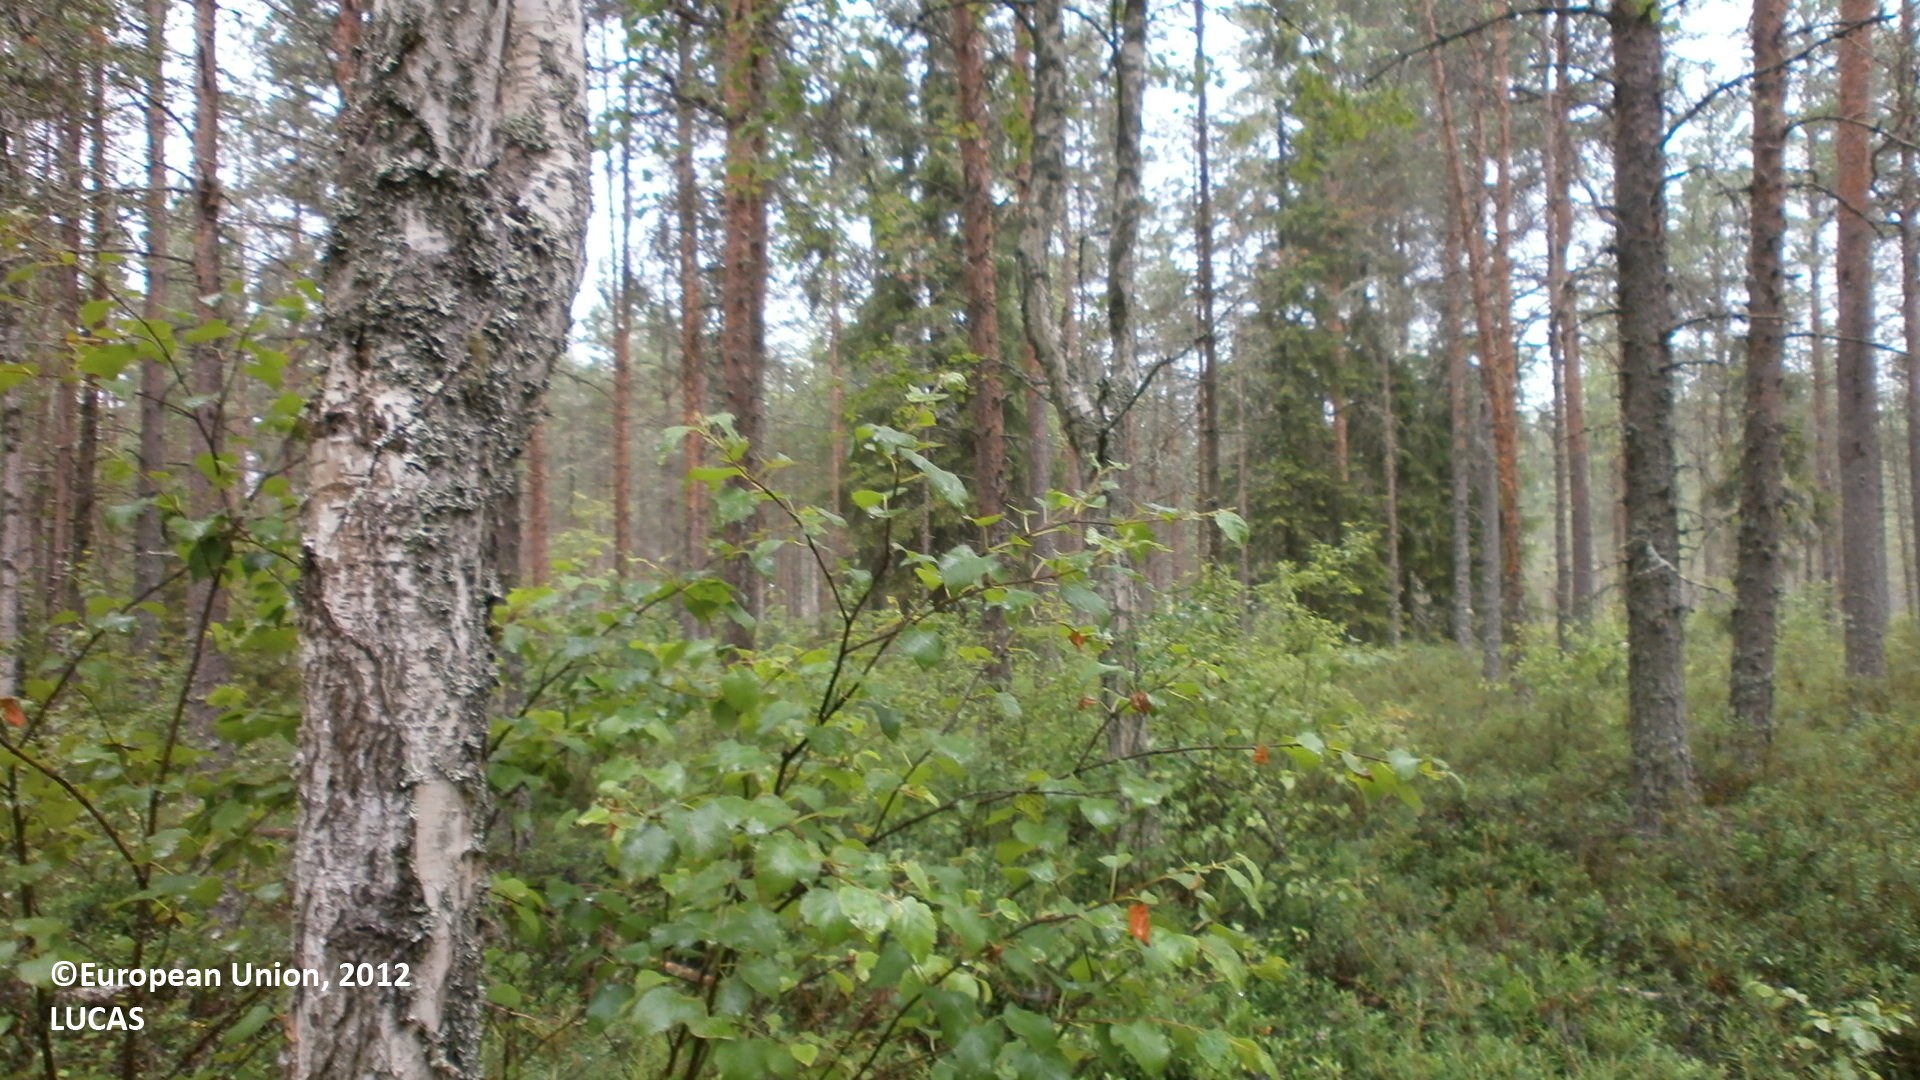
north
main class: Woodland
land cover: Pine dominated coniferous woodland
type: boreal forest
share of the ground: 50 - 75 %
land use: Forestry
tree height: > 5 m
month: July
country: FI
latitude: 64.0663
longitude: 23.8132
